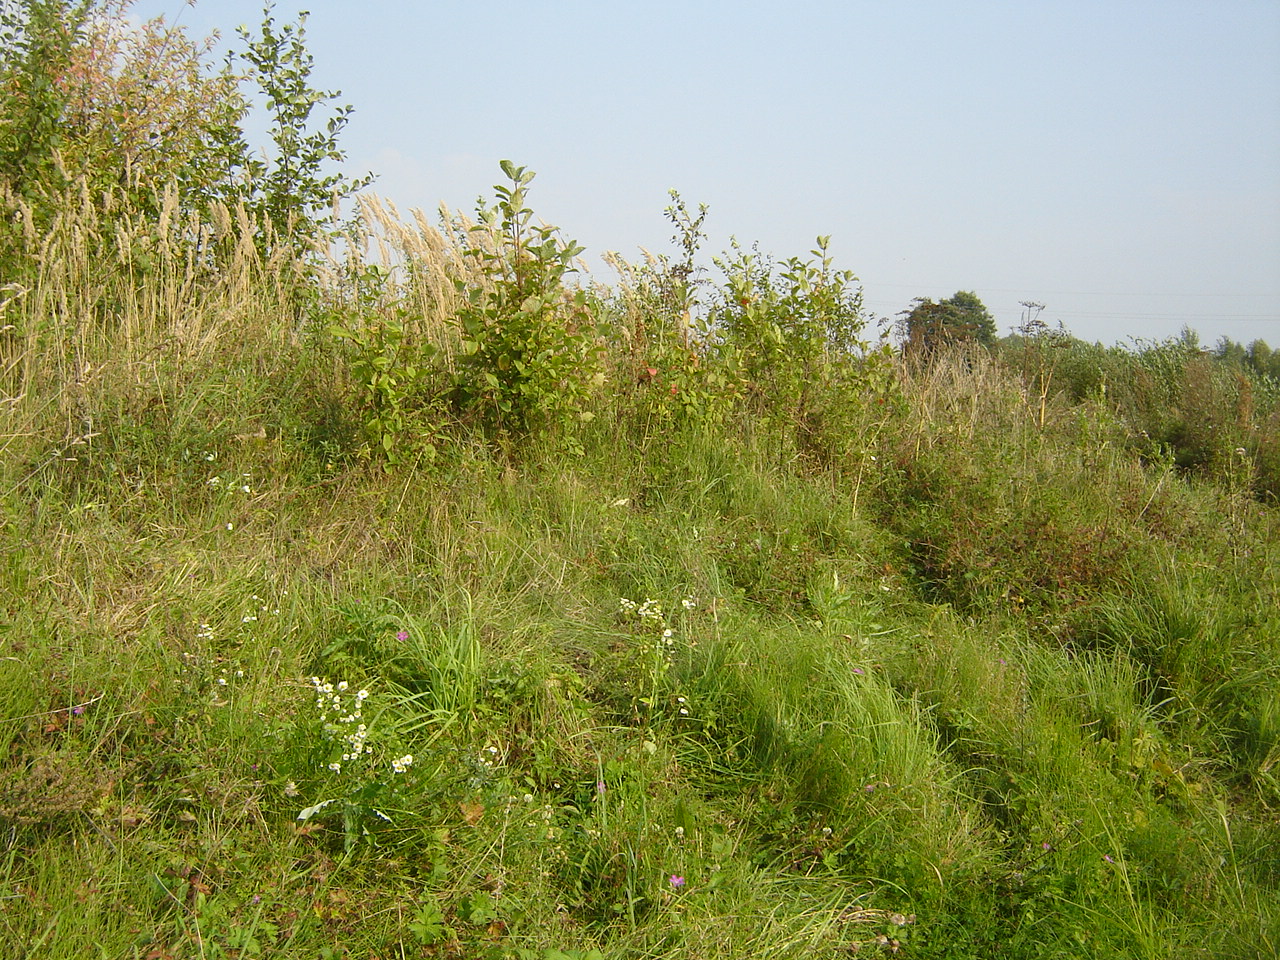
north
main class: Grassland
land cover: Spontaneously vegetated surfaces
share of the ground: > 75 %
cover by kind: herbaceous plants 100 %
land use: Semi-natural and natural areas not in use
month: September
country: LT
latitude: 54.5462
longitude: 25.1601
